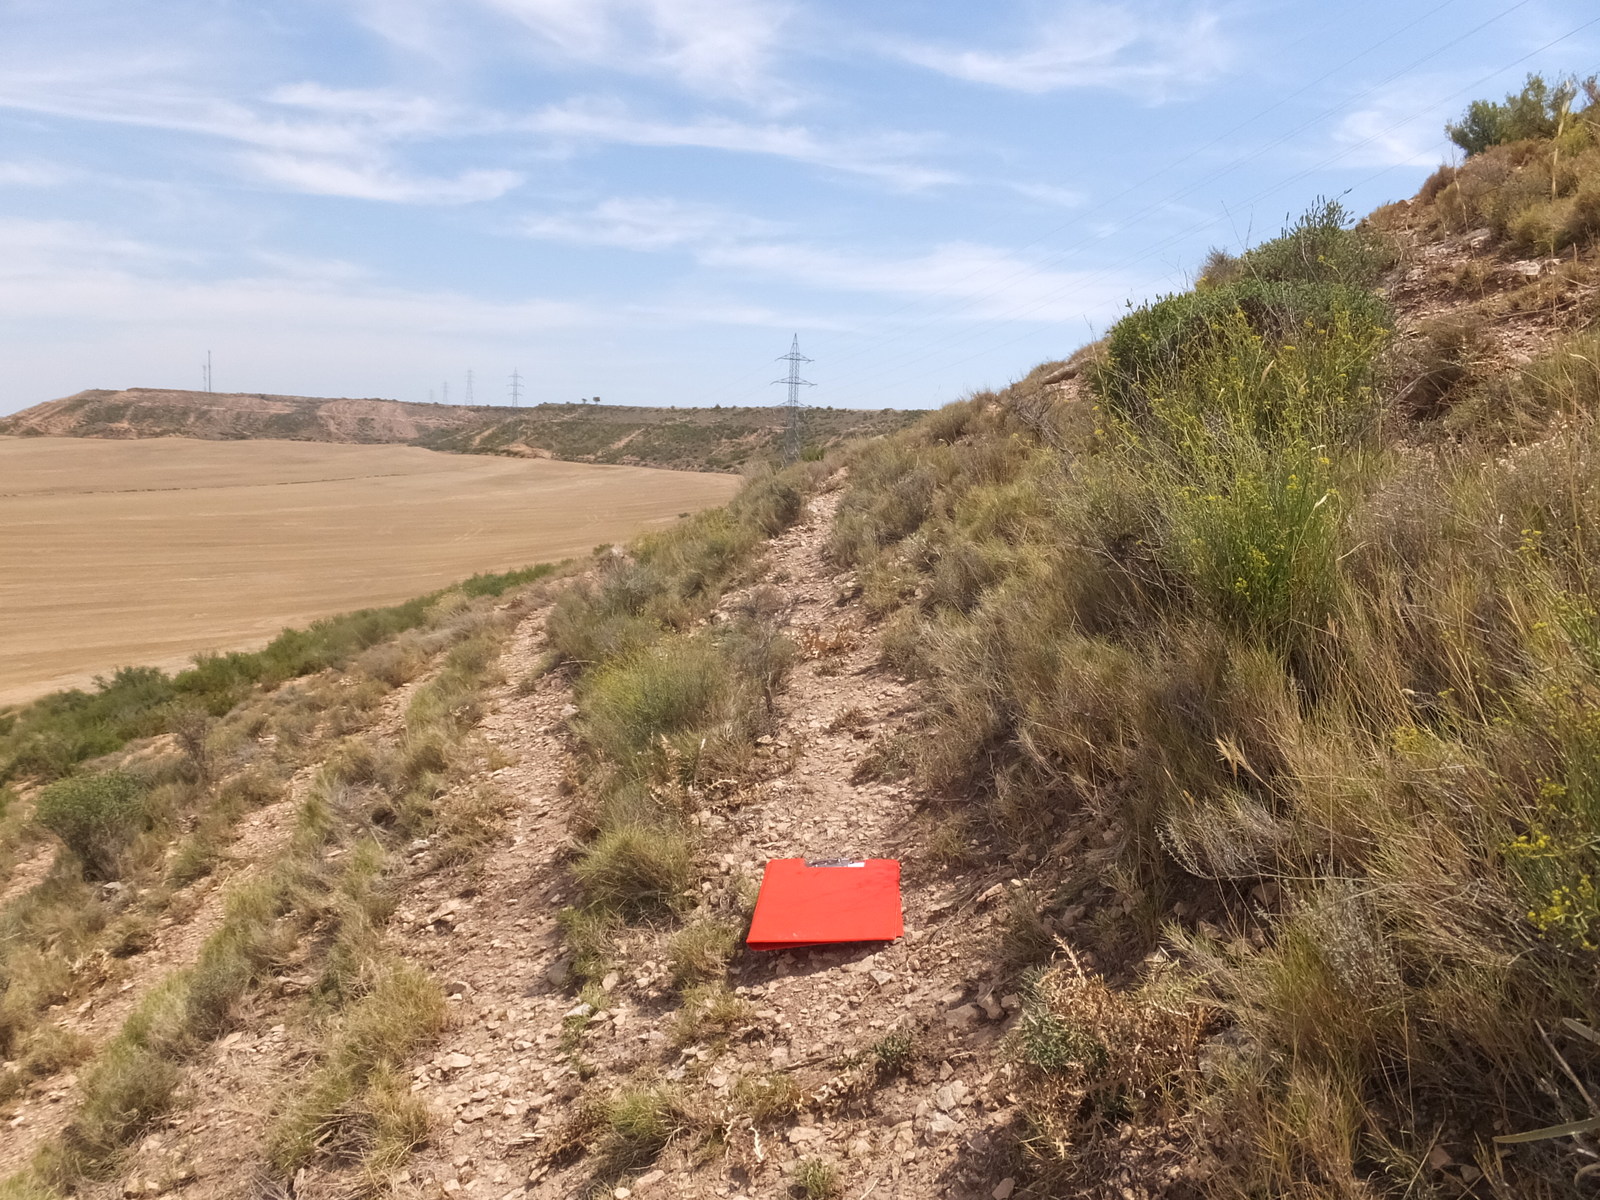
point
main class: Shrubland
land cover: Shrubland without tree cover
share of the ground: > 75 %
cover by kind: shrubs 70 %, herbaceous plants 20 %, consolidated bare surface 10 %
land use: Semi-natural and natural areas not in use
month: August
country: ES
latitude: 41.4821
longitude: 0.1540
